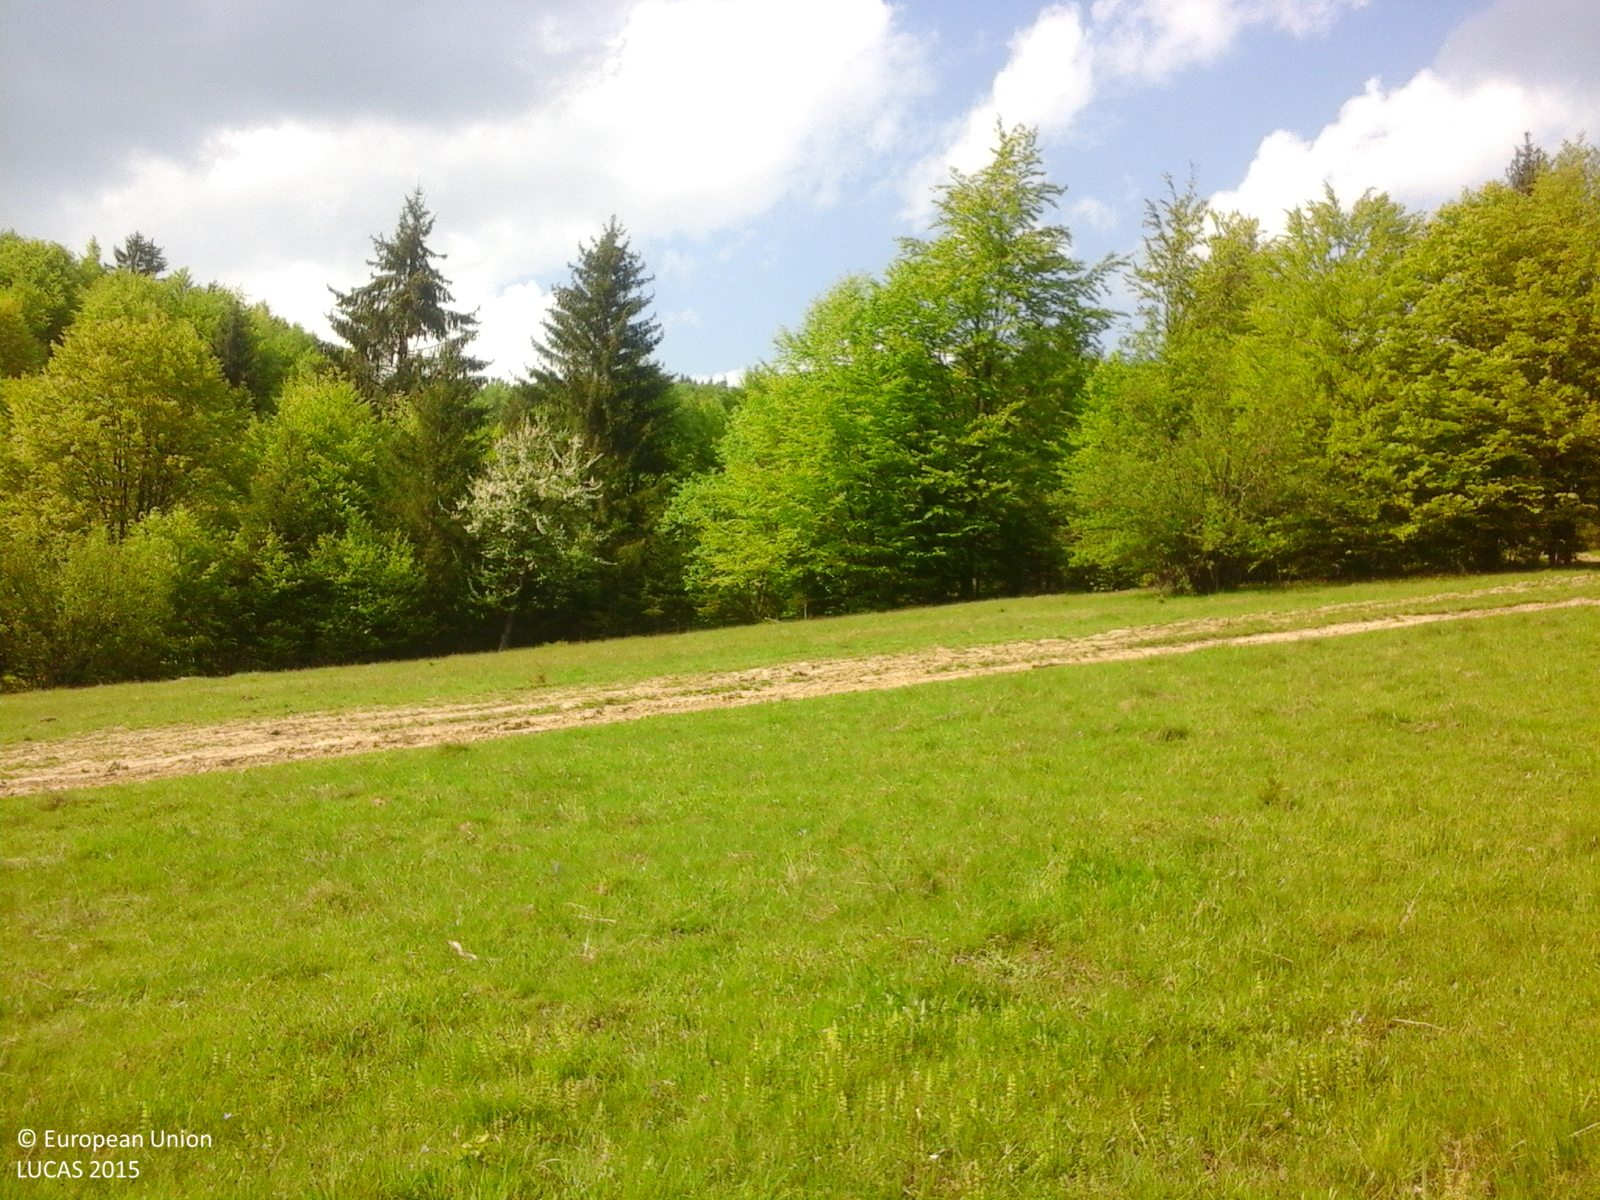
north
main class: Grassland
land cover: Grassland without tree/shrub cover
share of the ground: > 75 %
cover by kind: herbaceous plants 100 %
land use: Agriculture (excluding fallow land and kitchen gardens)
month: May
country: RO
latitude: 45.6037
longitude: 25.9466
